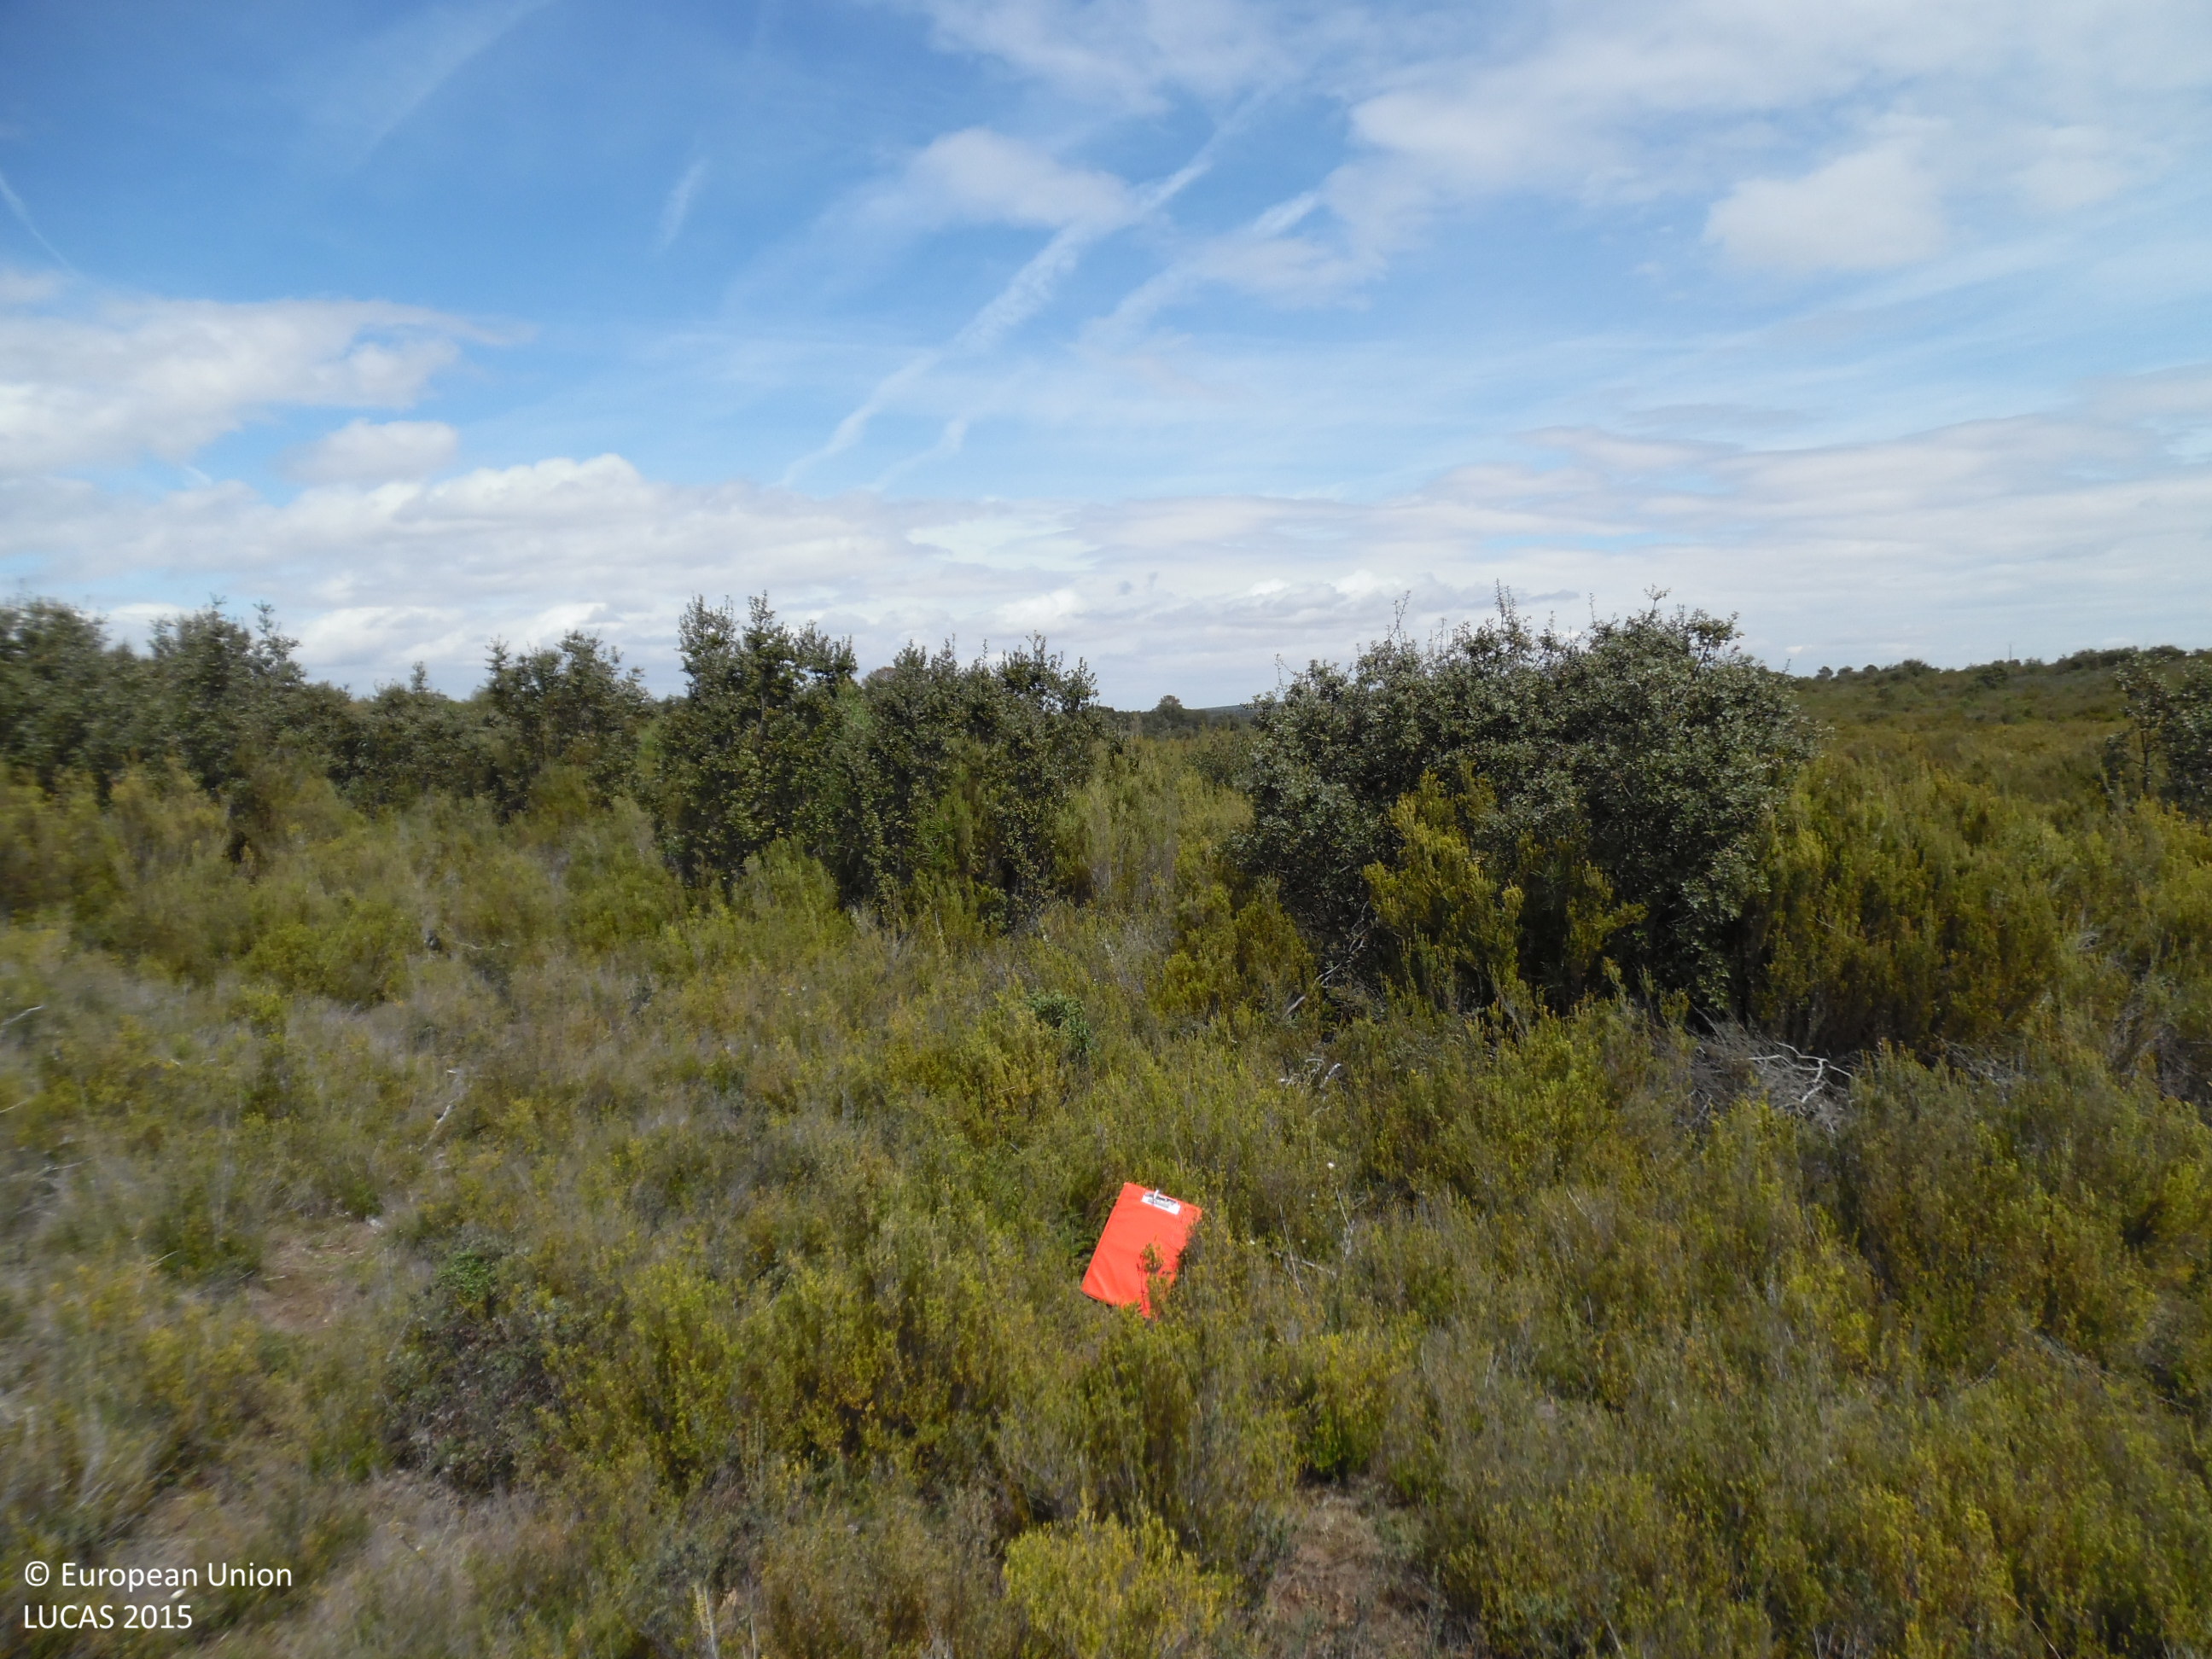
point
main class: Shrubland
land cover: Shrubland with sparse tree cover
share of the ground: > 75 %
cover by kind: shrubs 95 %, broadleaved forest trees 5 %
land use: Semi-natural and natural areas not in use
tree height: < 5 m
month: April
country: ES
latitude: 42.2265
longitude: -6.0595
